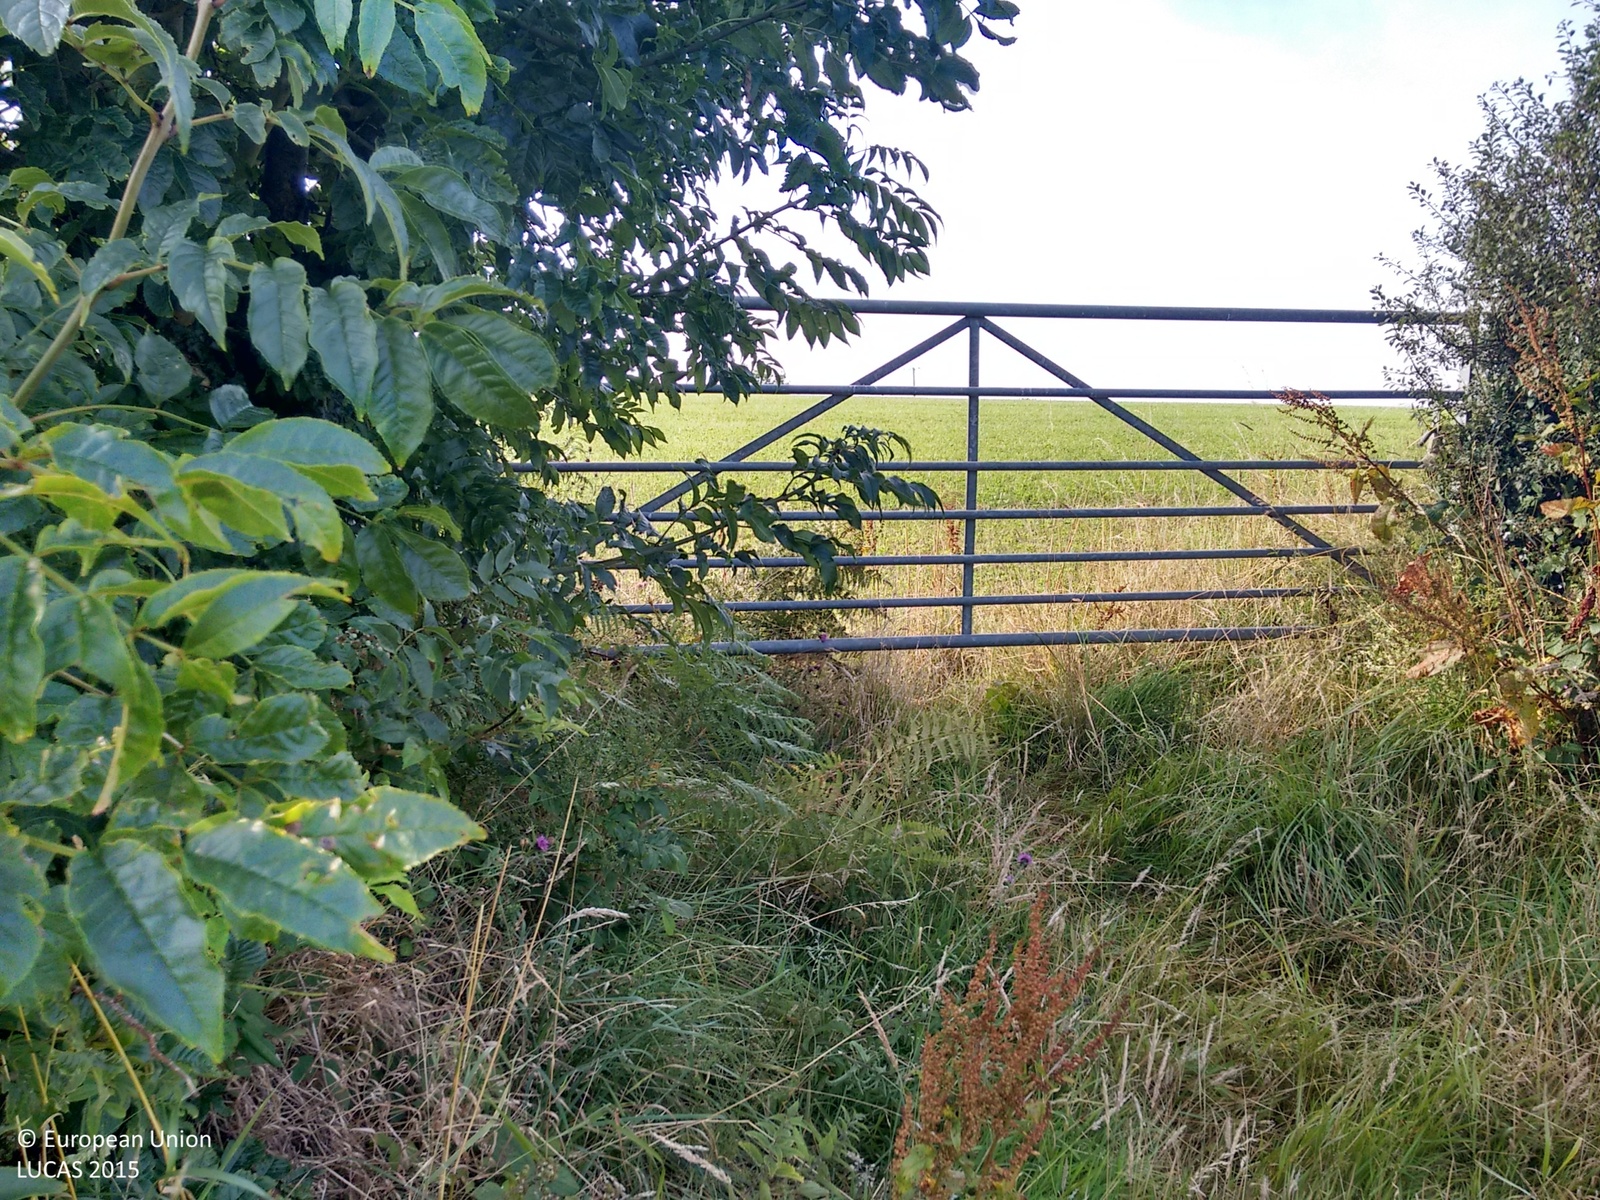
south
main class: Grassland
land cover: Grassland without tree/shrub cover
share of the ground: > 75 %
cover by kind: herbaceous plants 100 %
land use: Agriculture (excluding fallow land and kitchen gardens)
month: August
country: GB
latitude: 50.4343
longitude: -4.3918
